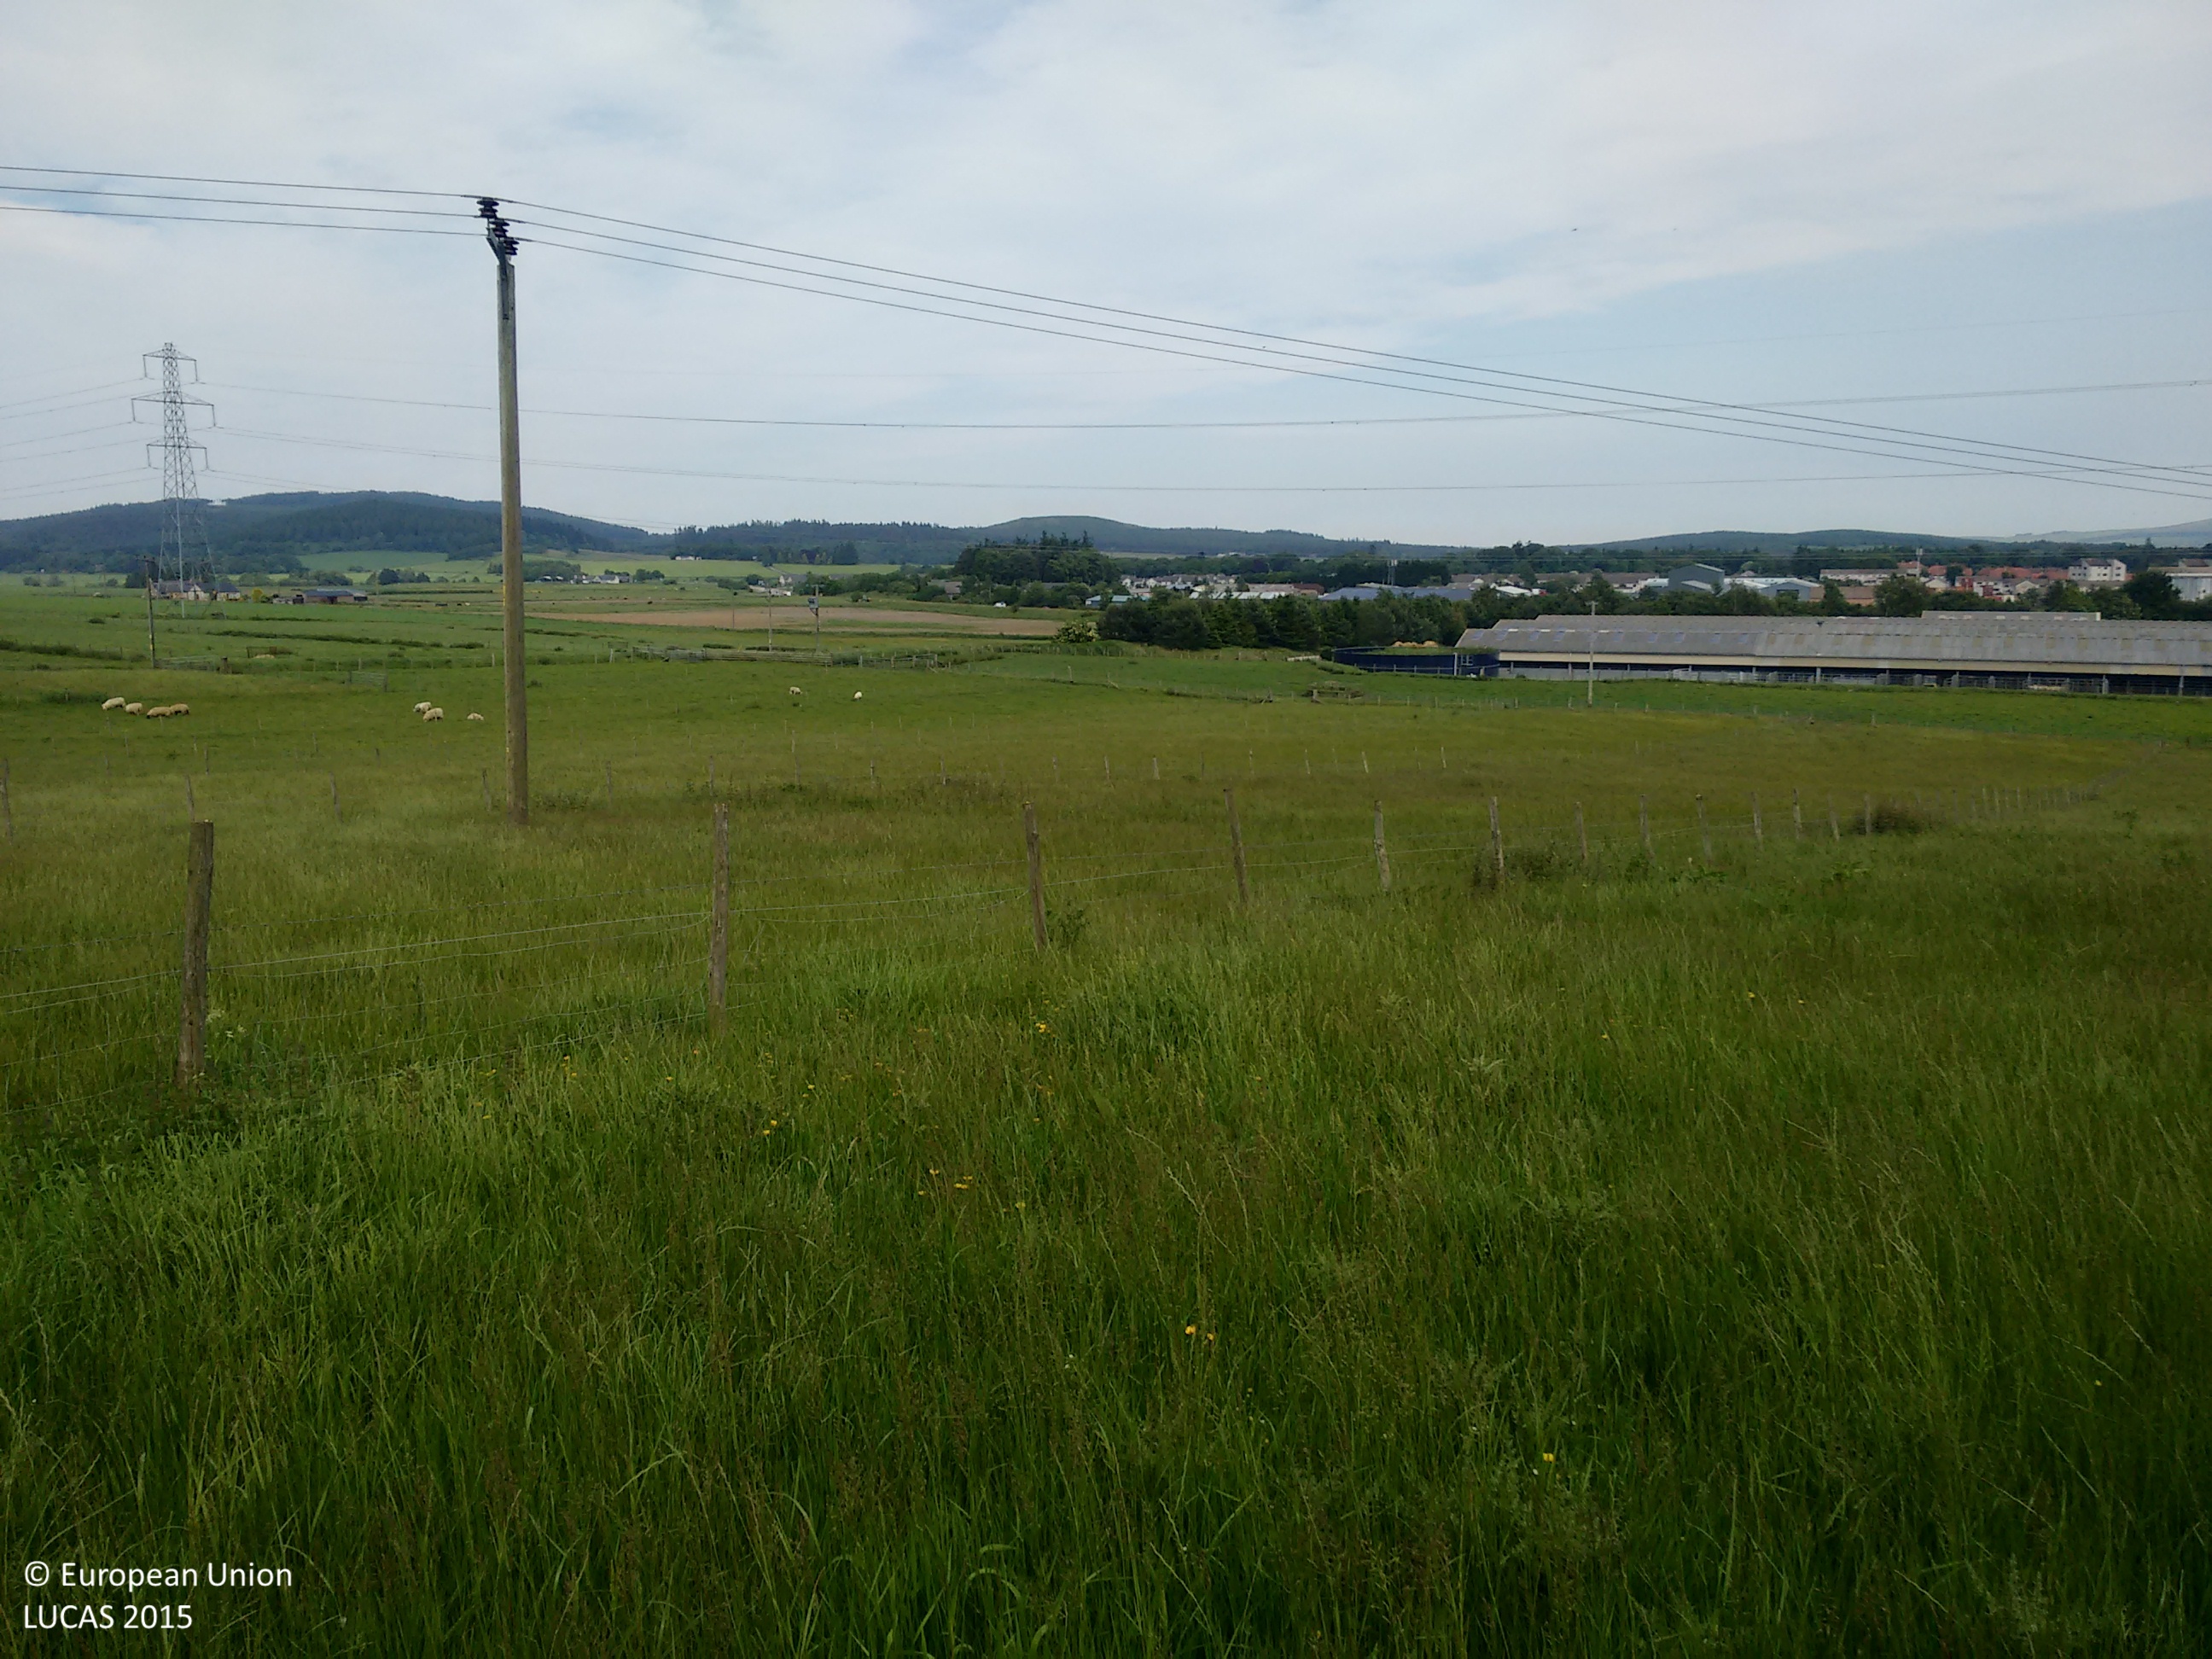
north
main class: Grassland
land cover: Grassland without tree/shrub cover
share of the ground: > 75 %
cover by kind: herbaceous plants 100 %
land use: Agriculture (excluding fallow land and kitchen gardens)
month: July
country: GB
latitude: 57.4397
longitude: -2.8028
